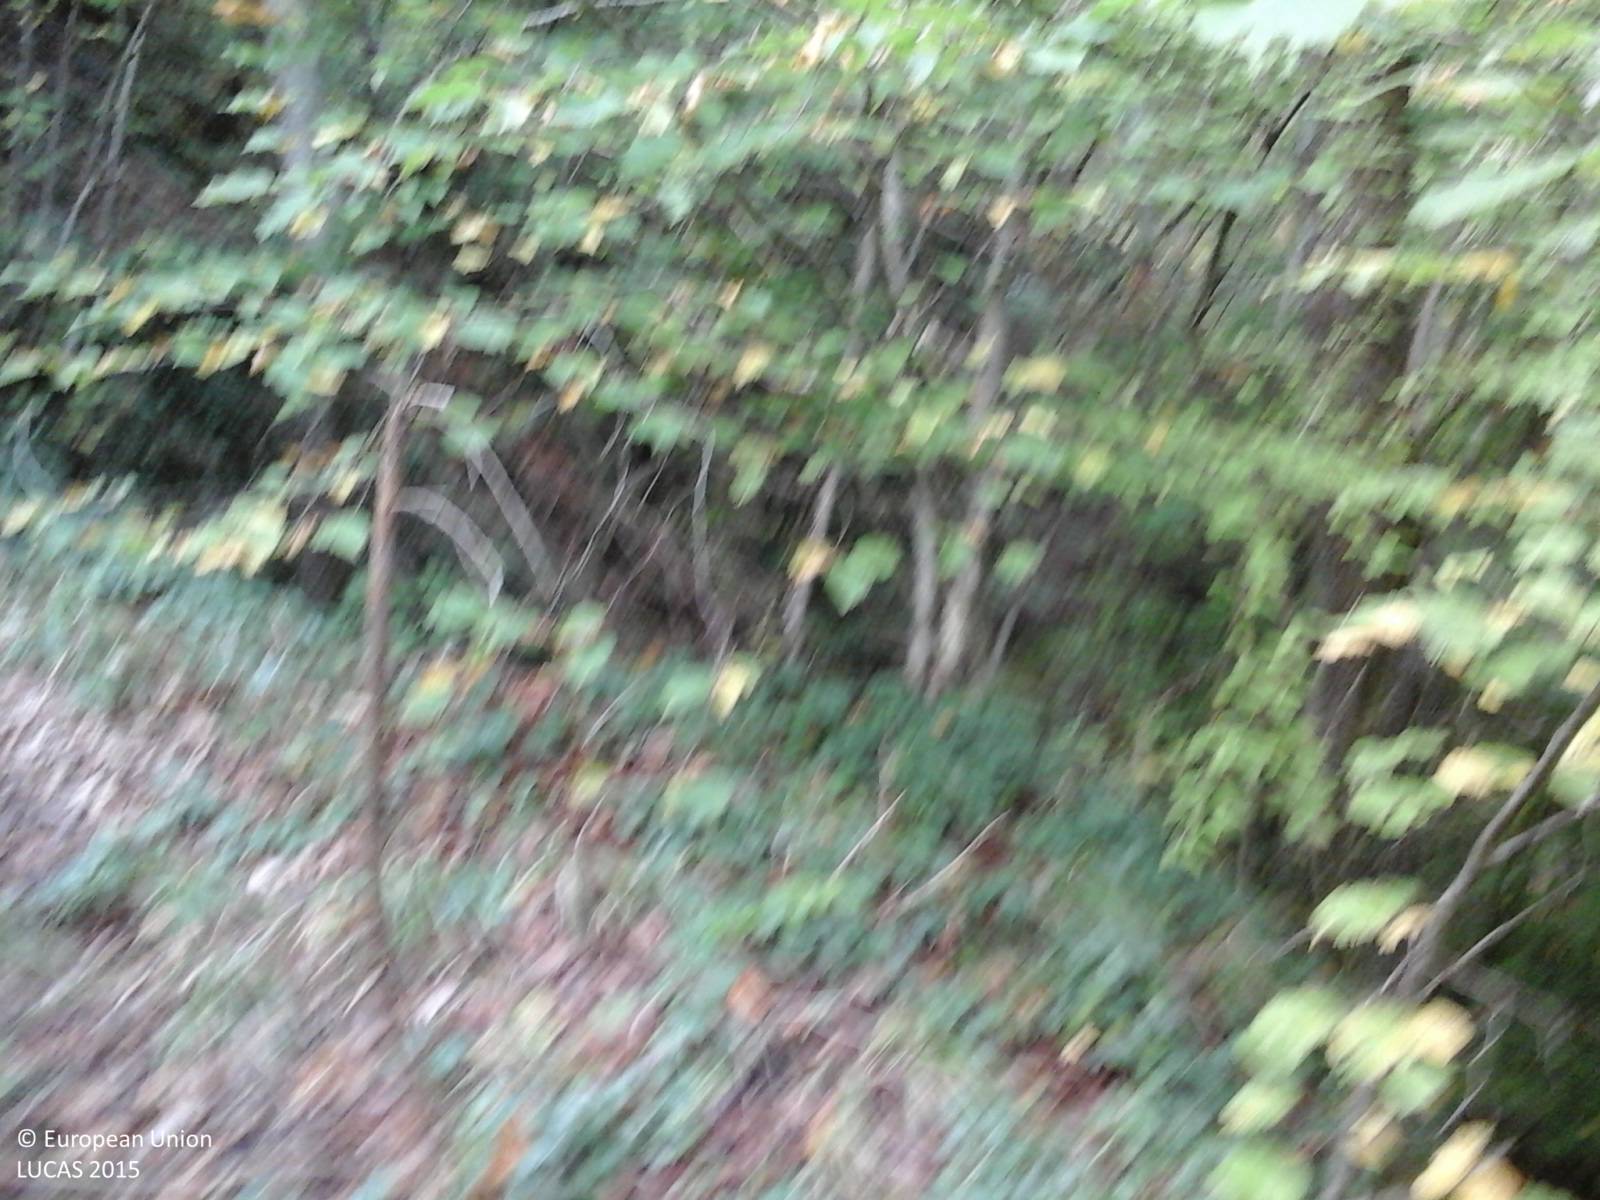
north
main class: Woodland
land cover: Broadleaved woodland
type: thermophilous deciduous forest
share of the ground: > 75 %
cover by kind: broadleaved forest trees 100 %
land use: Forestry
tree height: > 5 m
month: October
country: IT
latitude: 42.5142
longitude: 13.1667
